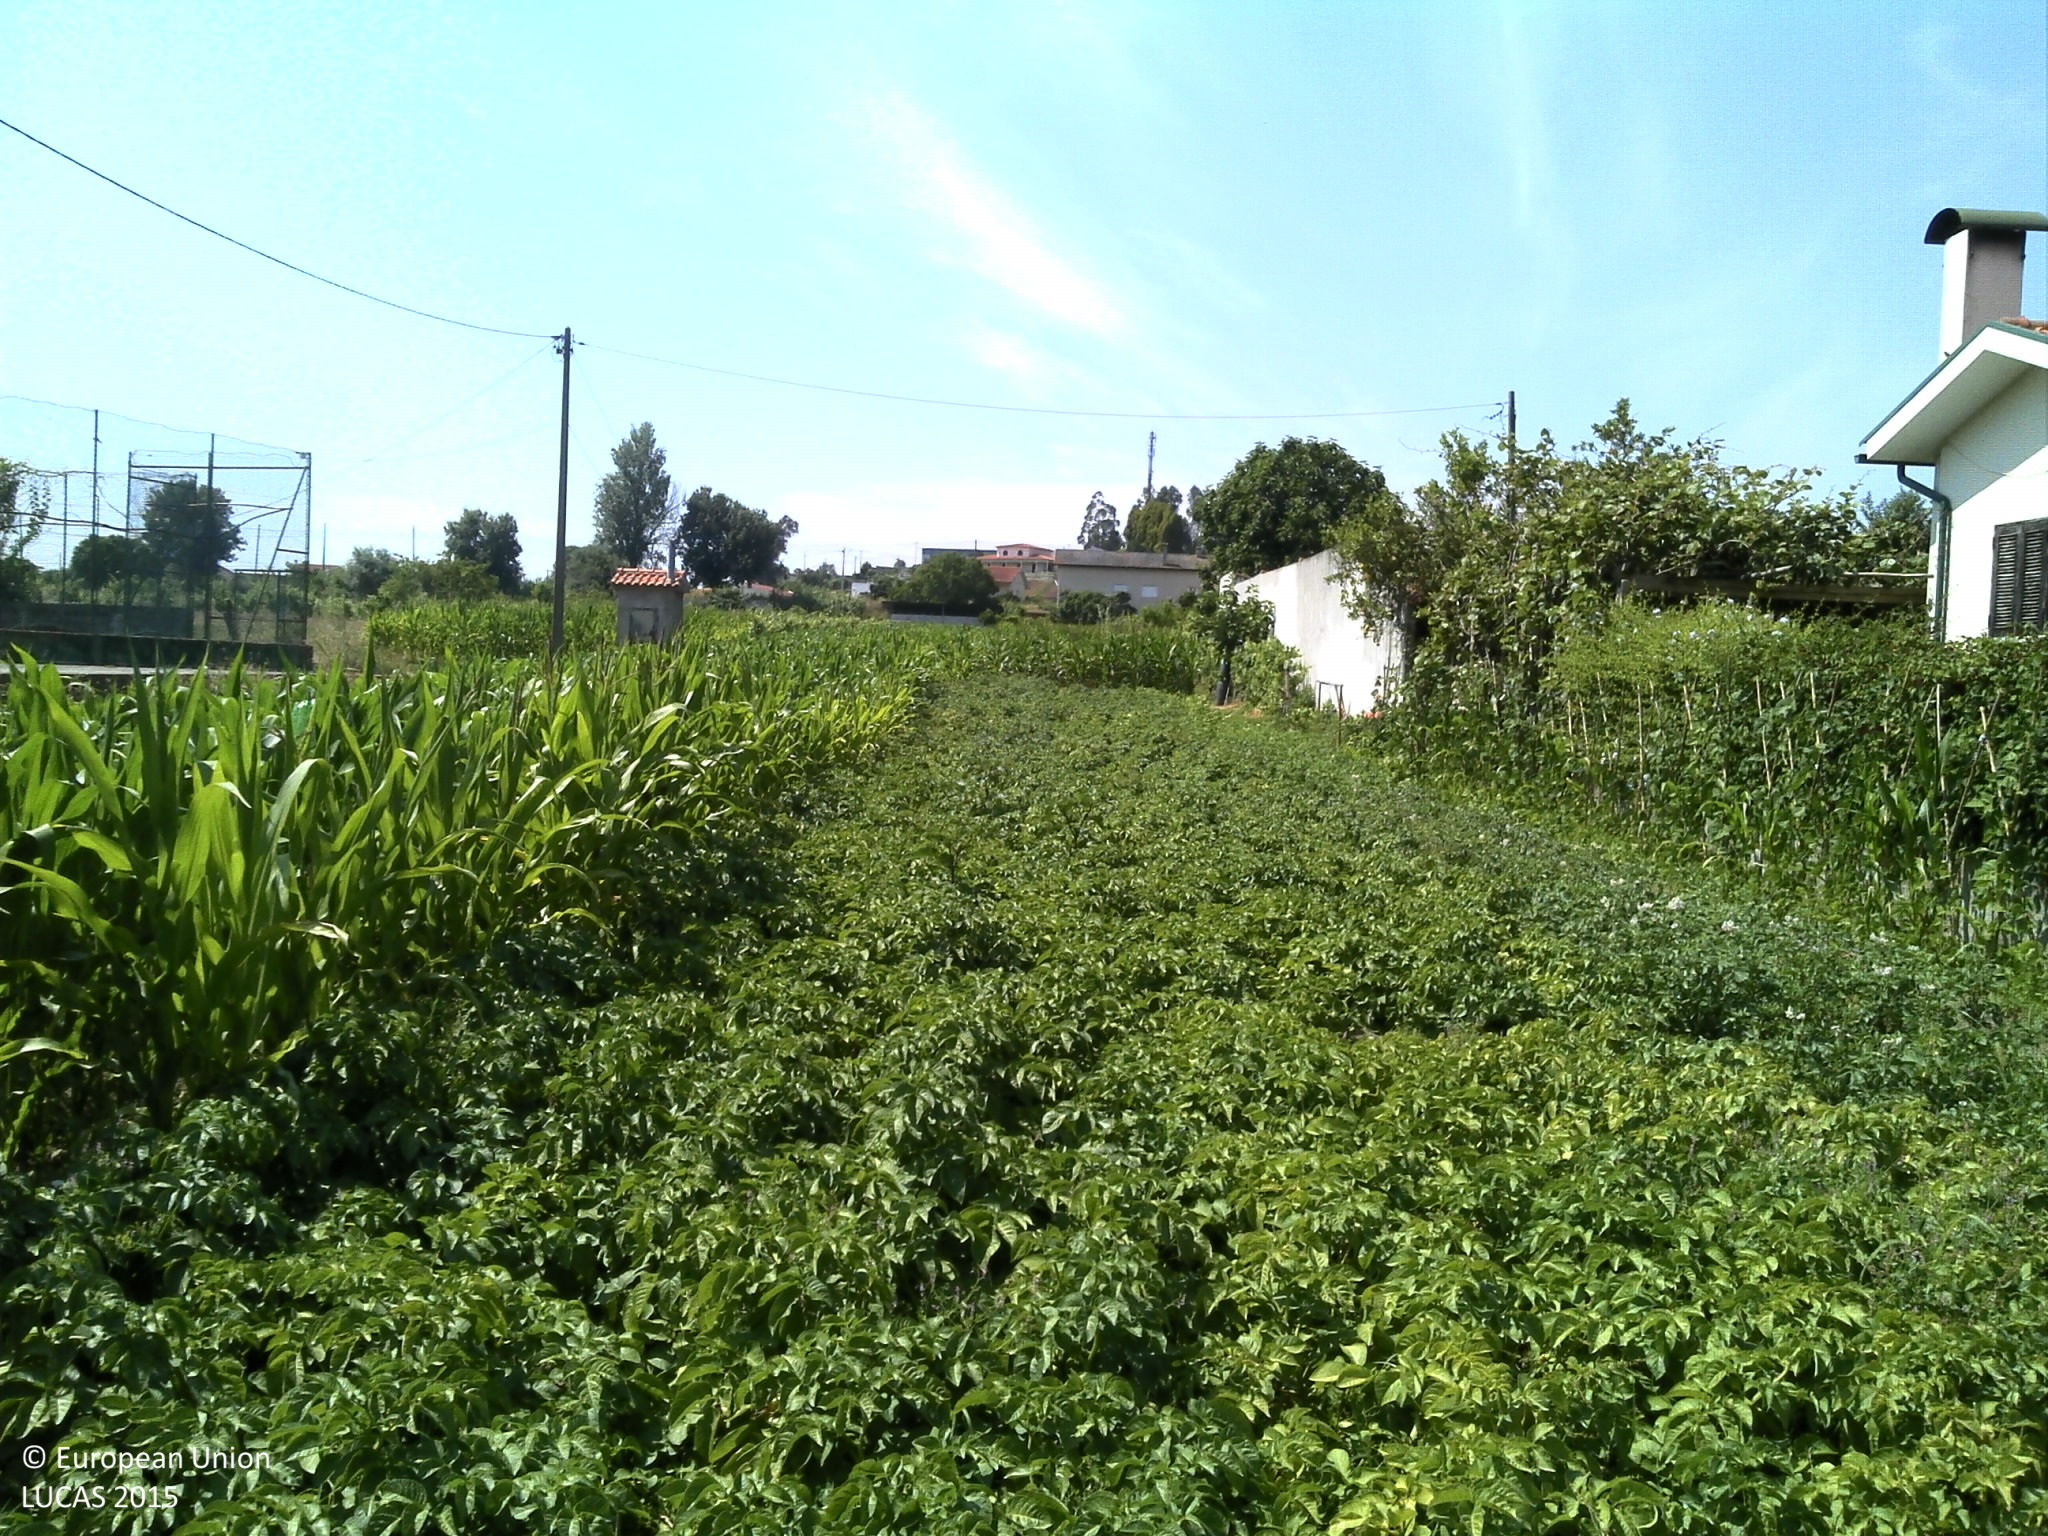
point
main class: Cropland
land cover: Potatoes
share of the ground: > 75 %
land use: Kitchen garden
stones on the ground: < 10 %
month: June
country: PT
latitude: 40.2203
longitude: -8.5481
